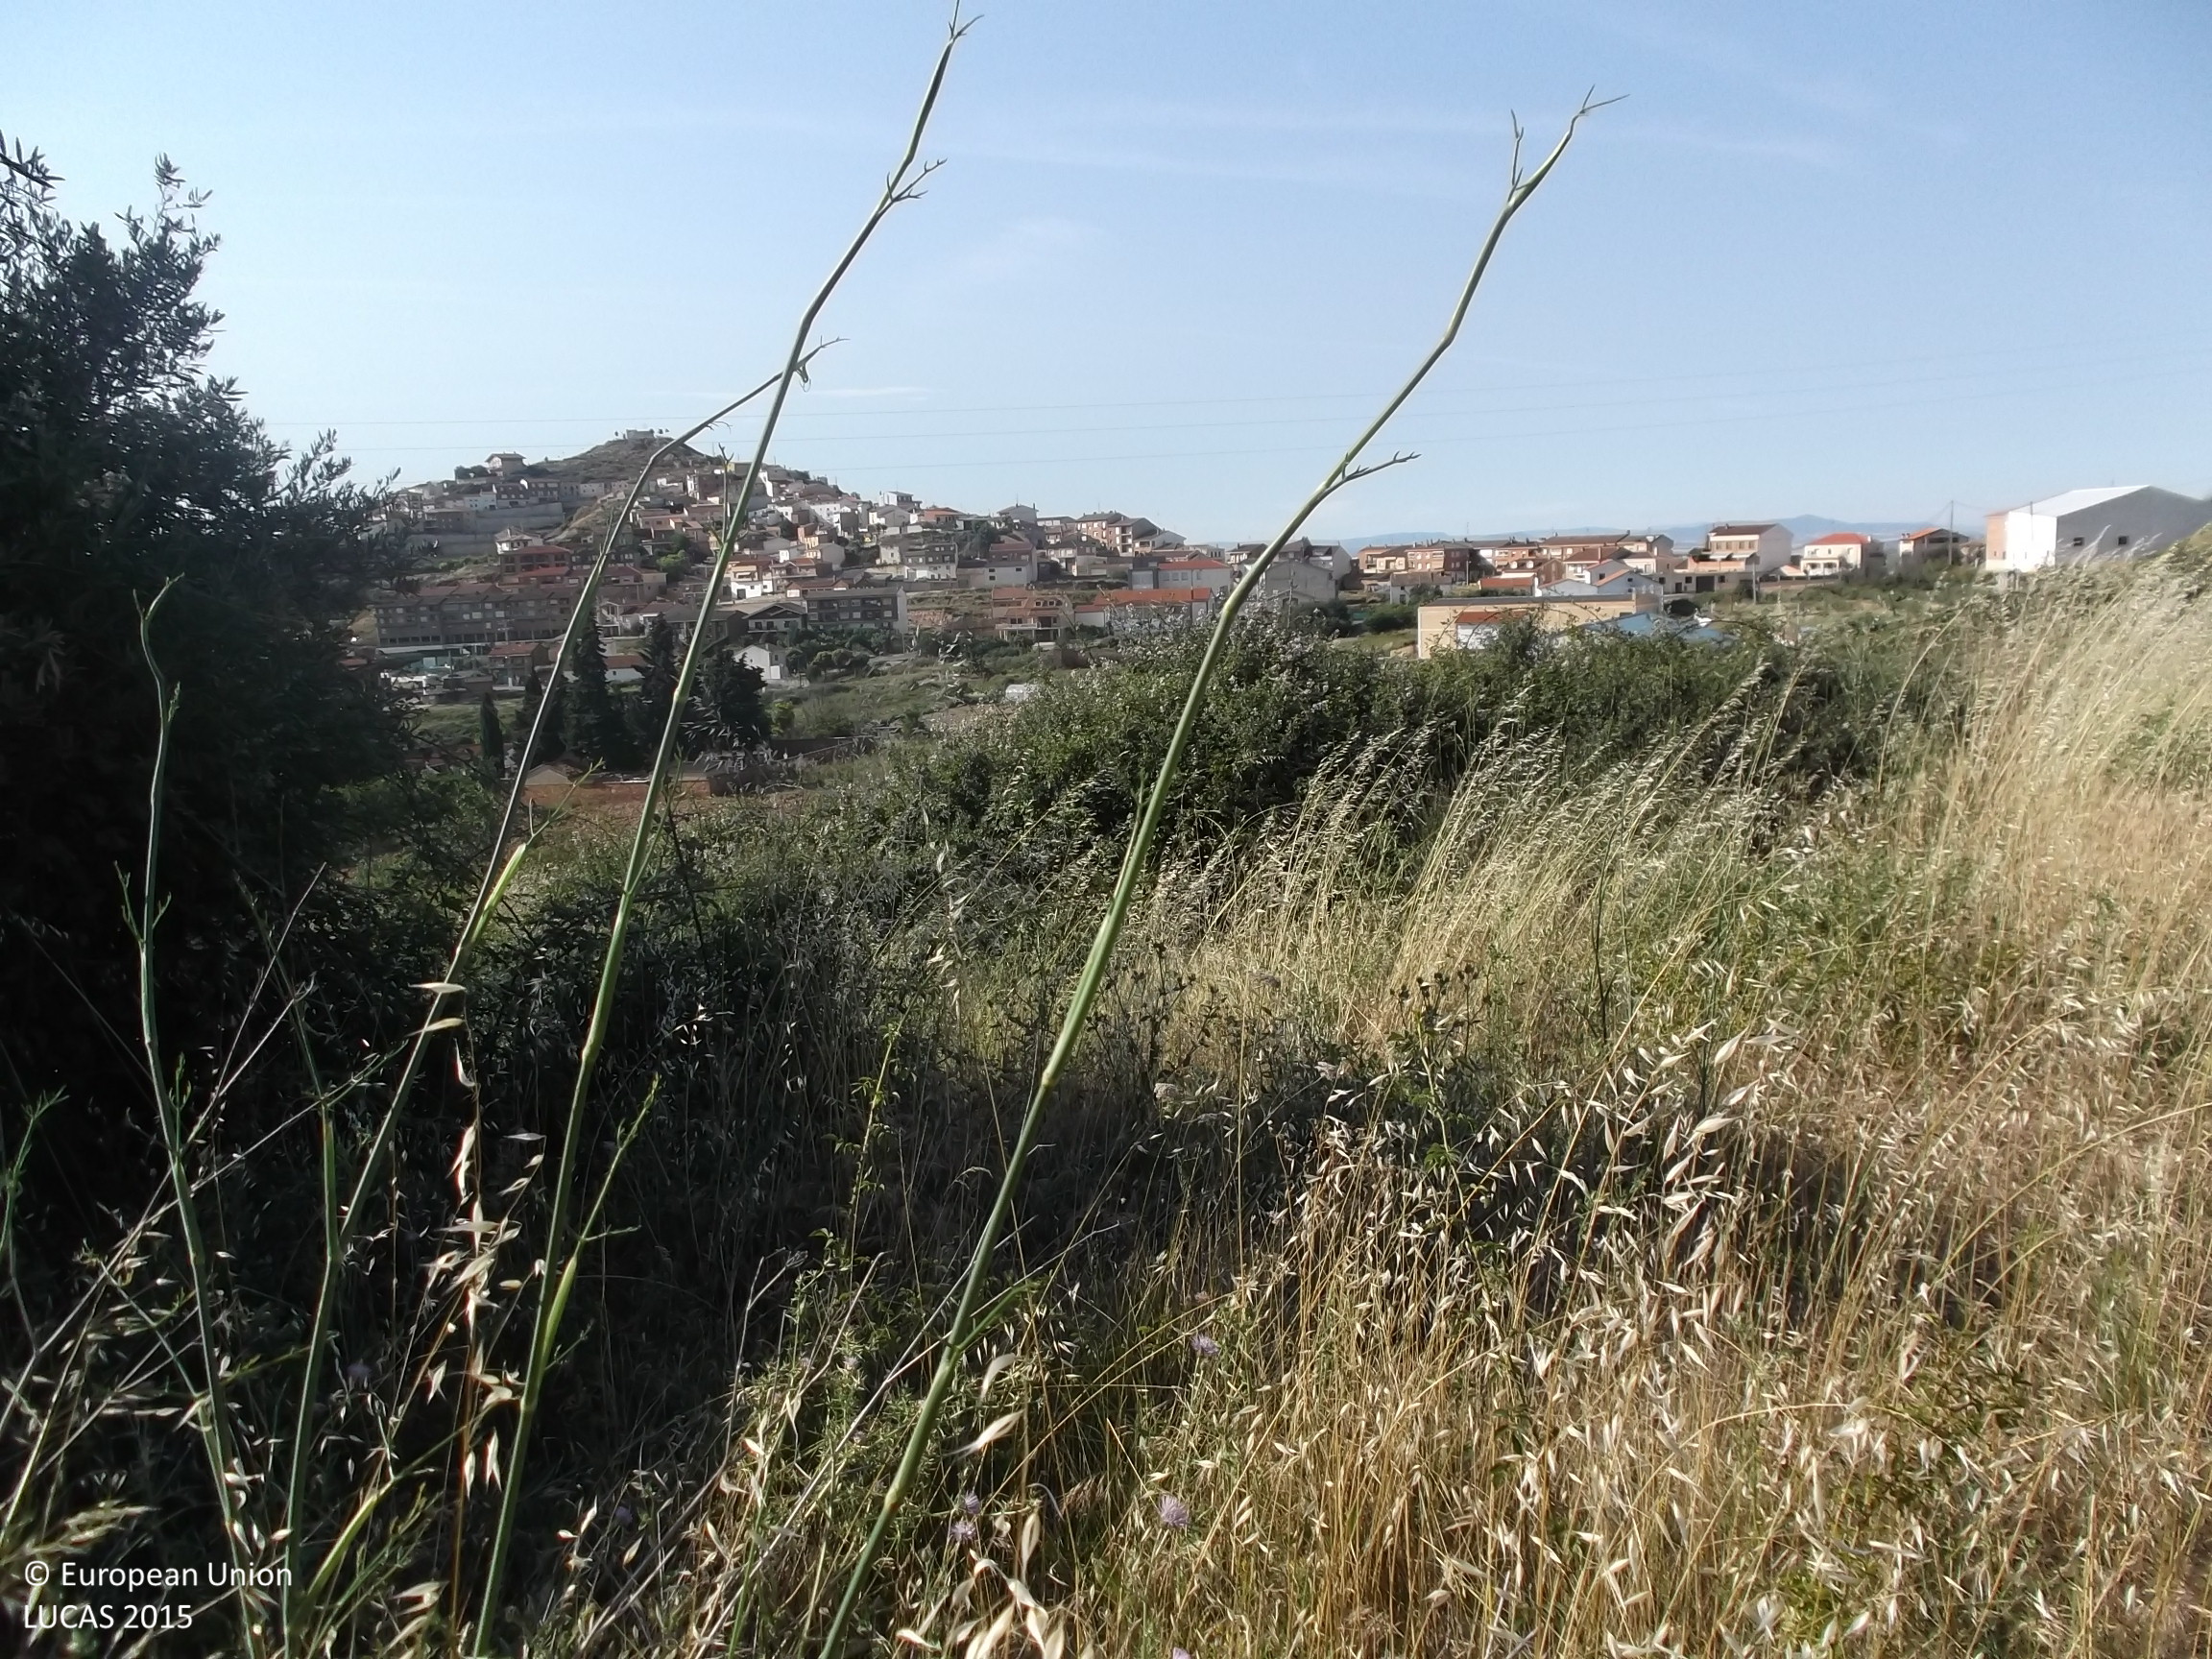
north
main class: Grassland
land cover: Spontaneously vegetated surfaces
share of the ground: > 75 %
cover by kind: herbaceous plants 90 %, unconsolidated bare surface 5 %
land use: Fallow land
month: June
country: ES
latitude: 42.3374
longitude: -2.1653
